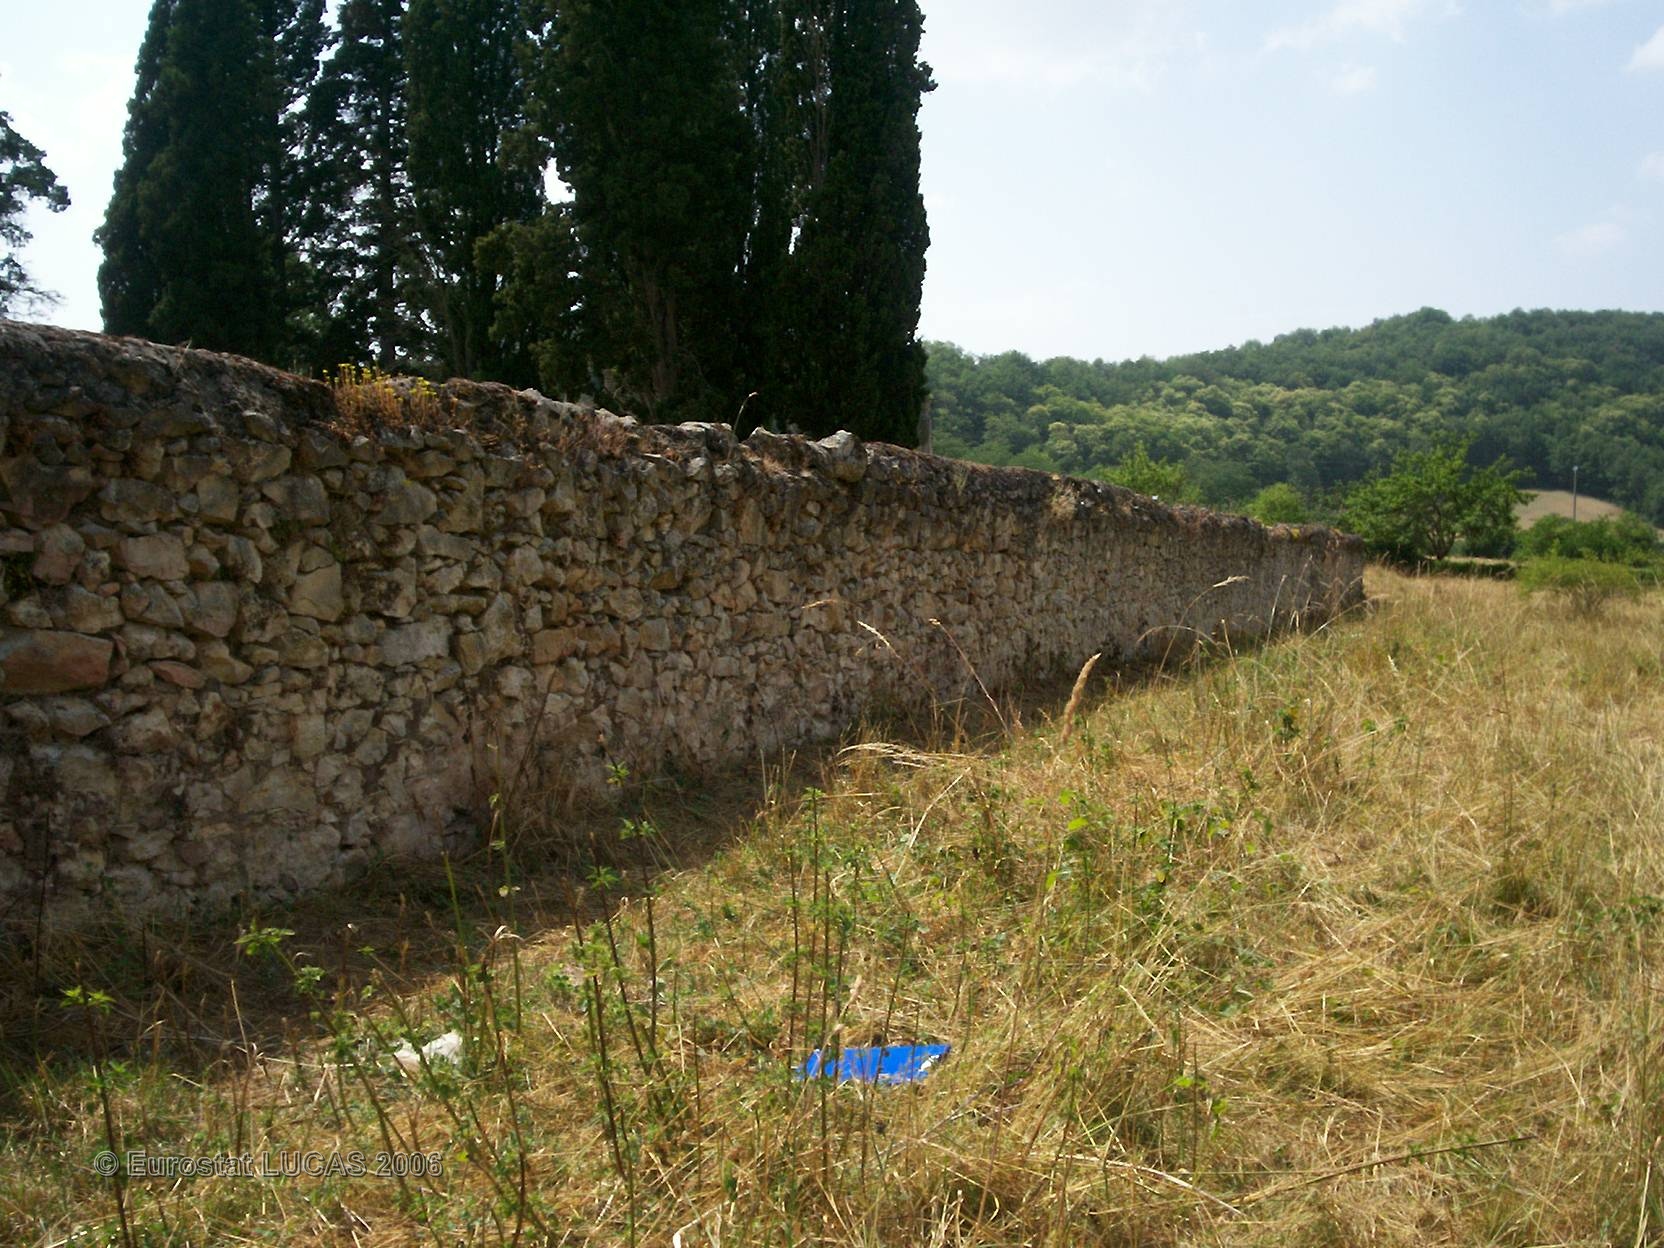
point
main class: Grassland
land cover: Grassland without tree/shrub cover
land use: Agriculture (excluding fallow land and kitchen gardens)
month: June
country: FR
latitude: 43.2223
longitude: 0.8794
